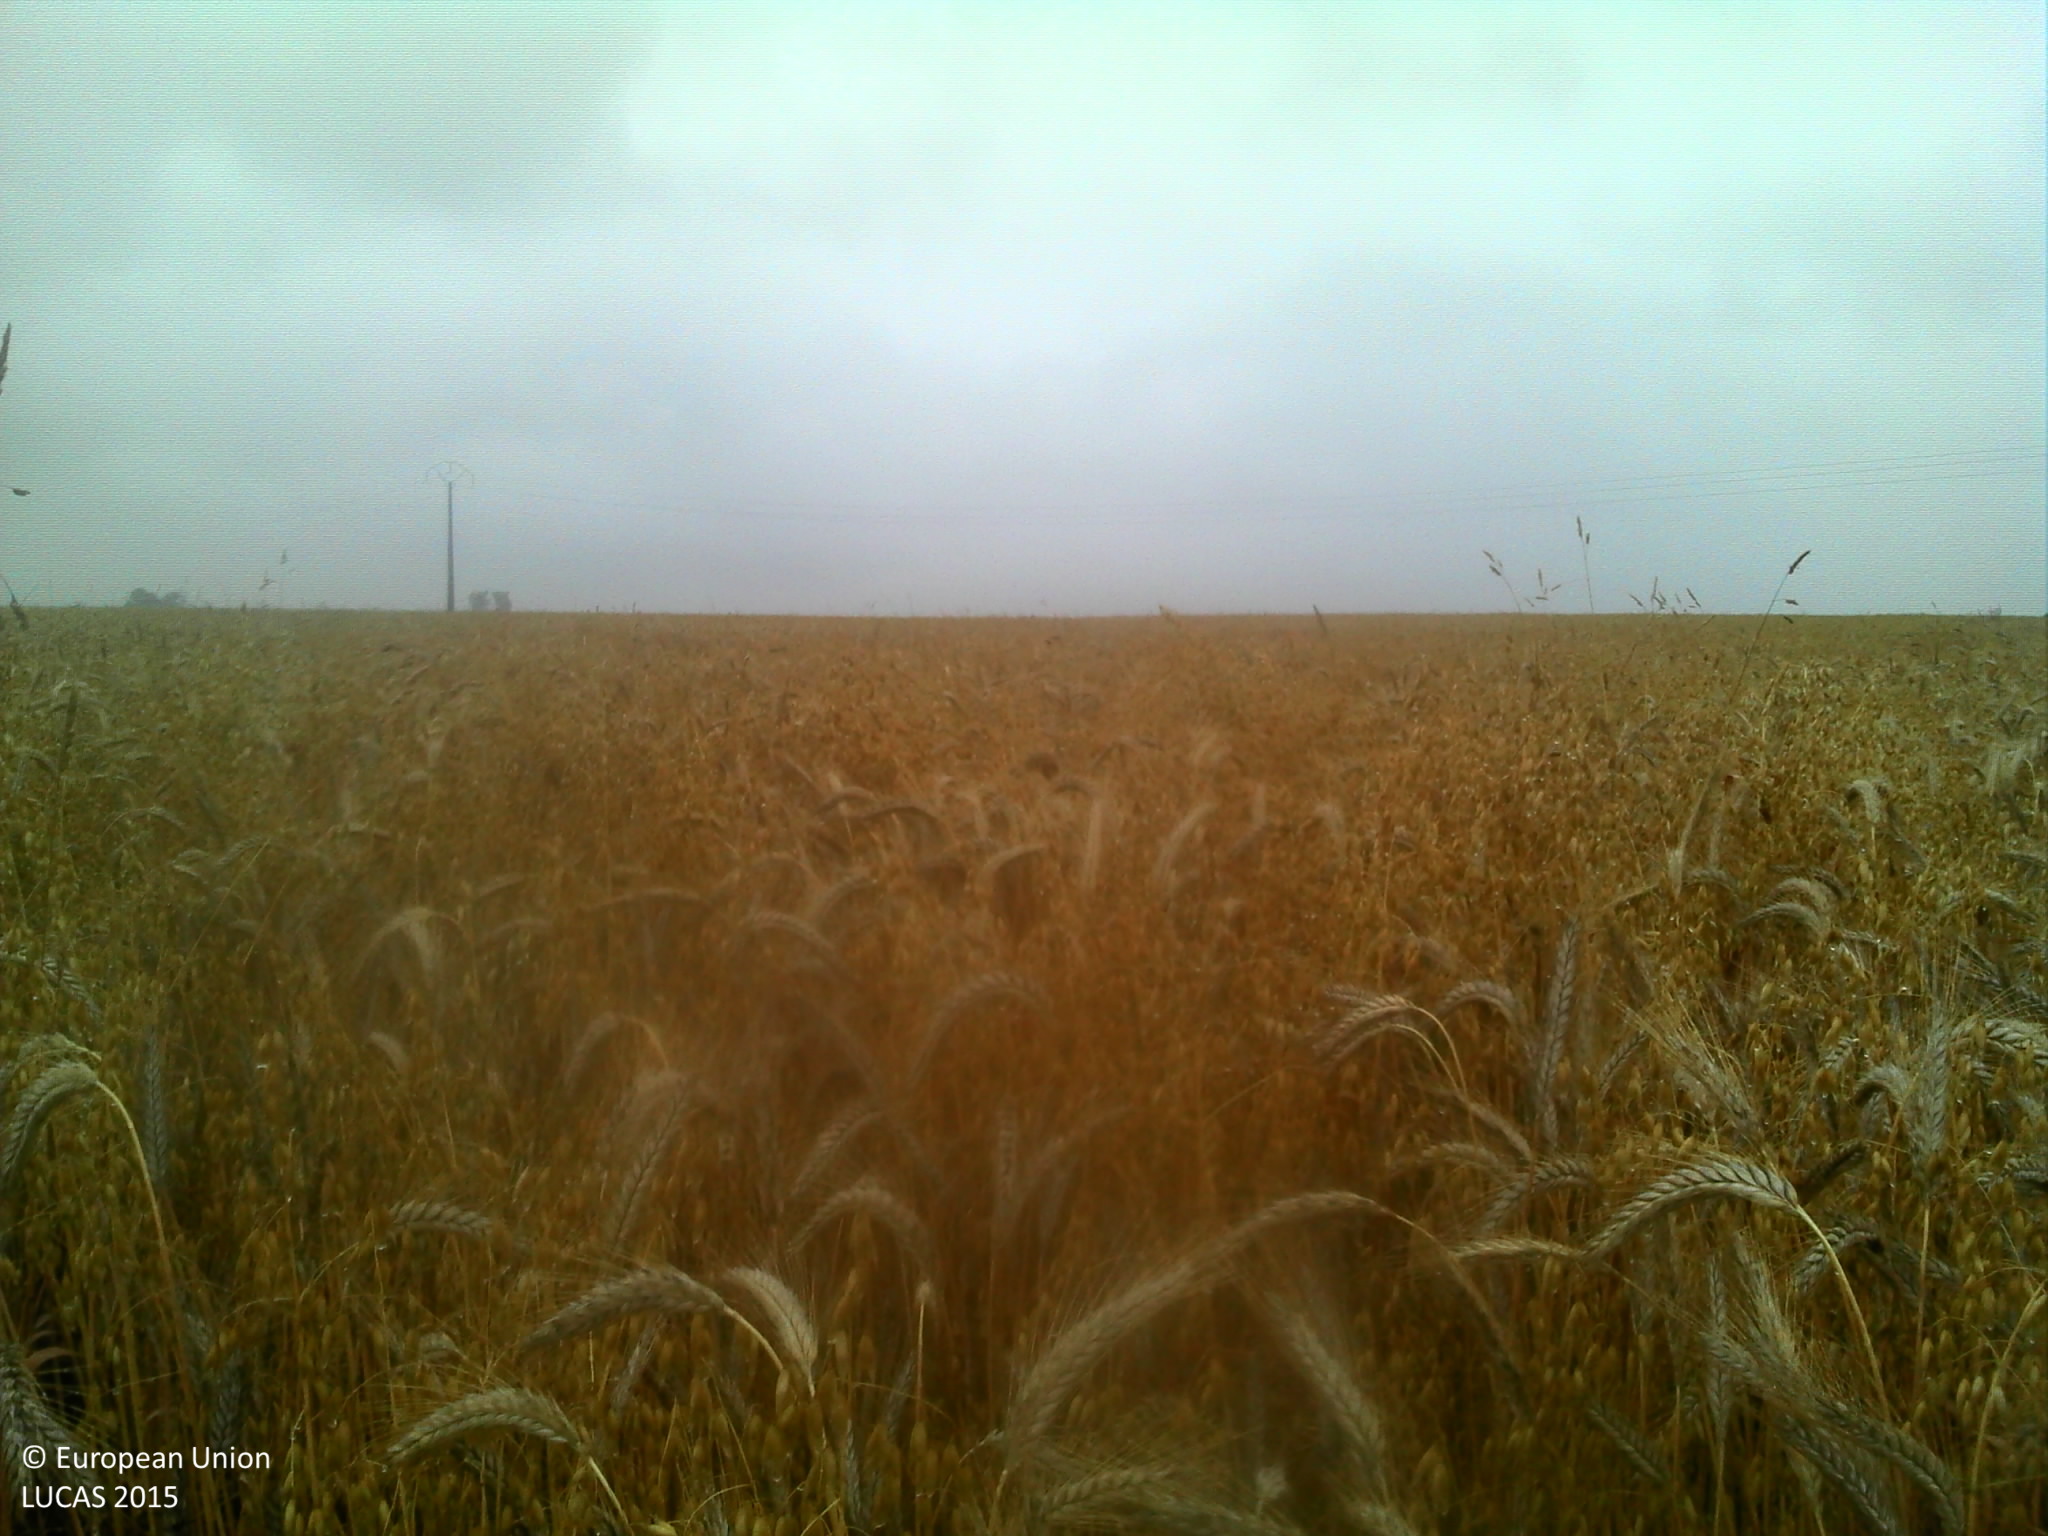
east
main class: Cropland
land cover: Mixed cereals for fodder
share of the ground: > 75 %
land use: Agriculture (excluding fallow land and kitchen gardens)
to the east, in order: Mixed cereals for fodder; Electric lines; Mixed cereals for fodder
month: July
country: BE
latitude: 50.1713
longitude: 4.7462
